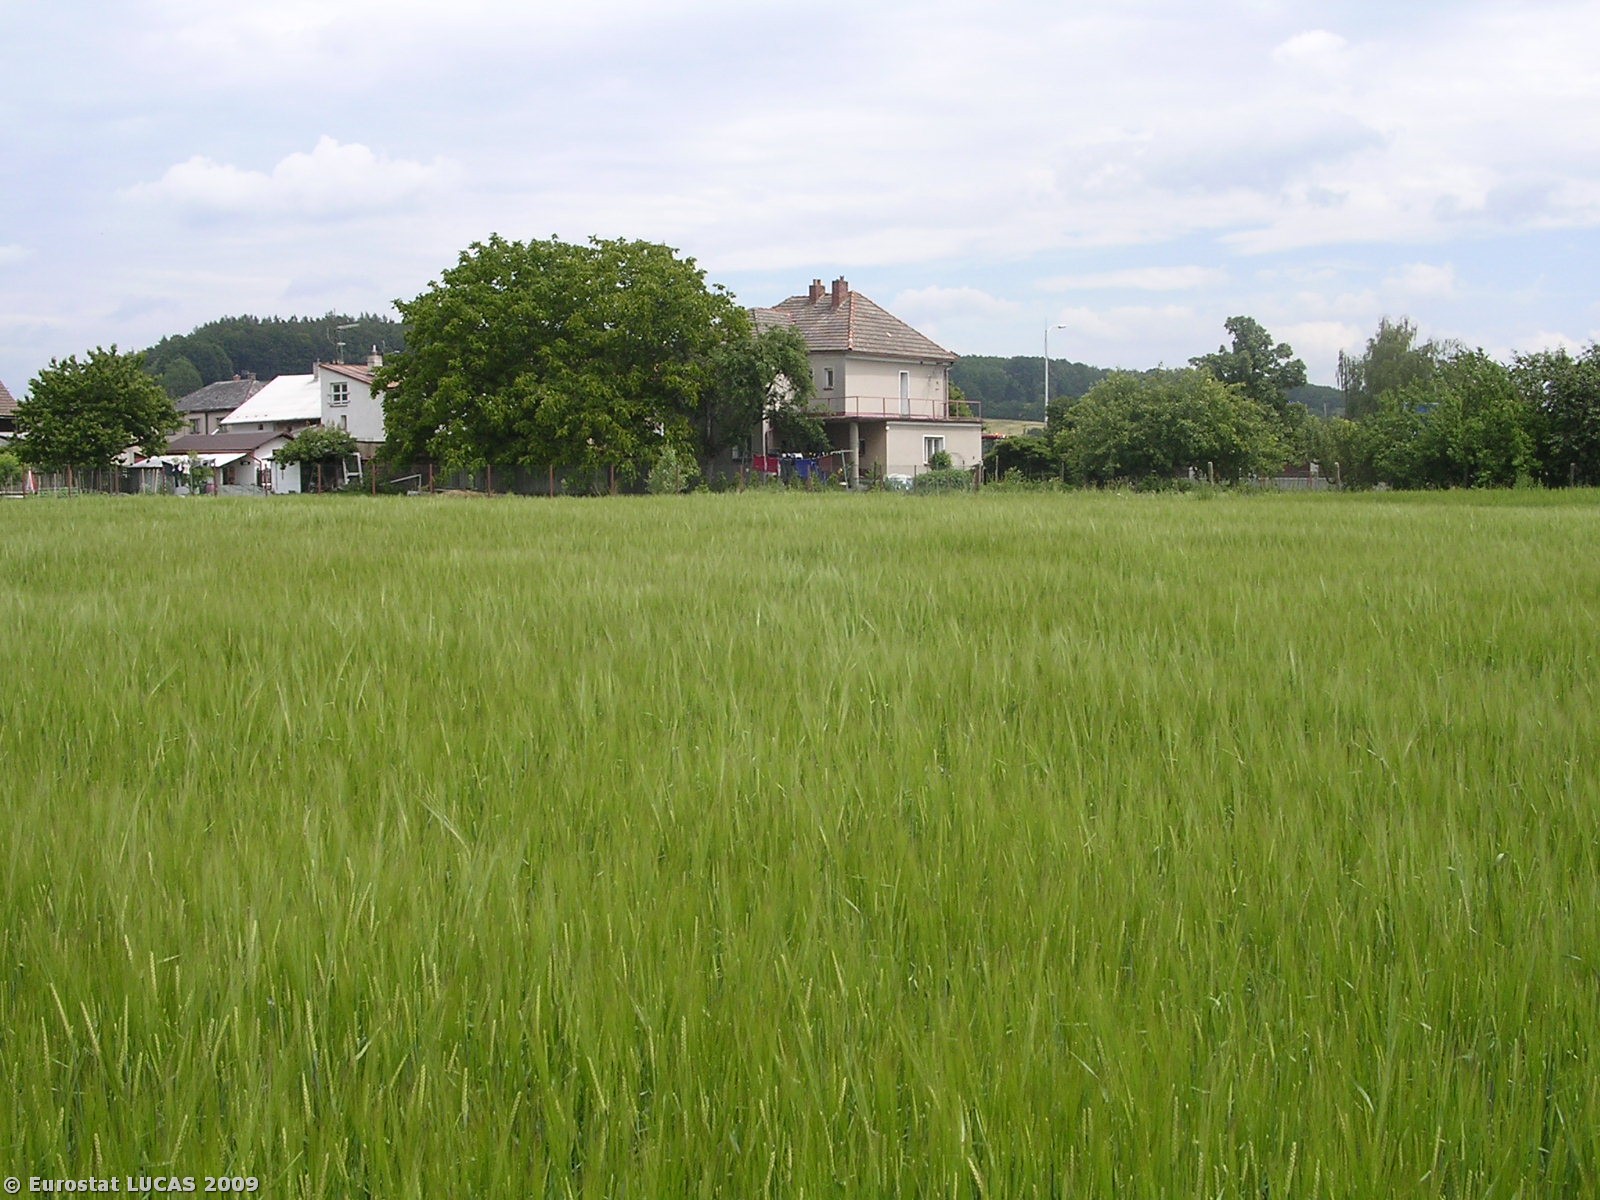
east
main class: Cropland
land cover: Barley
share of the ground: > 75 %
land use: Agriculture (excluding fallow land and kitchen gardens)
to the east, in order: Barley; Electric lines; Barley; Grassland without tree/shrub cover; Fences; Artificial constructions in urban areas
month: June
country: CZ
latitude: 50.4875
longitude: 15.0347
